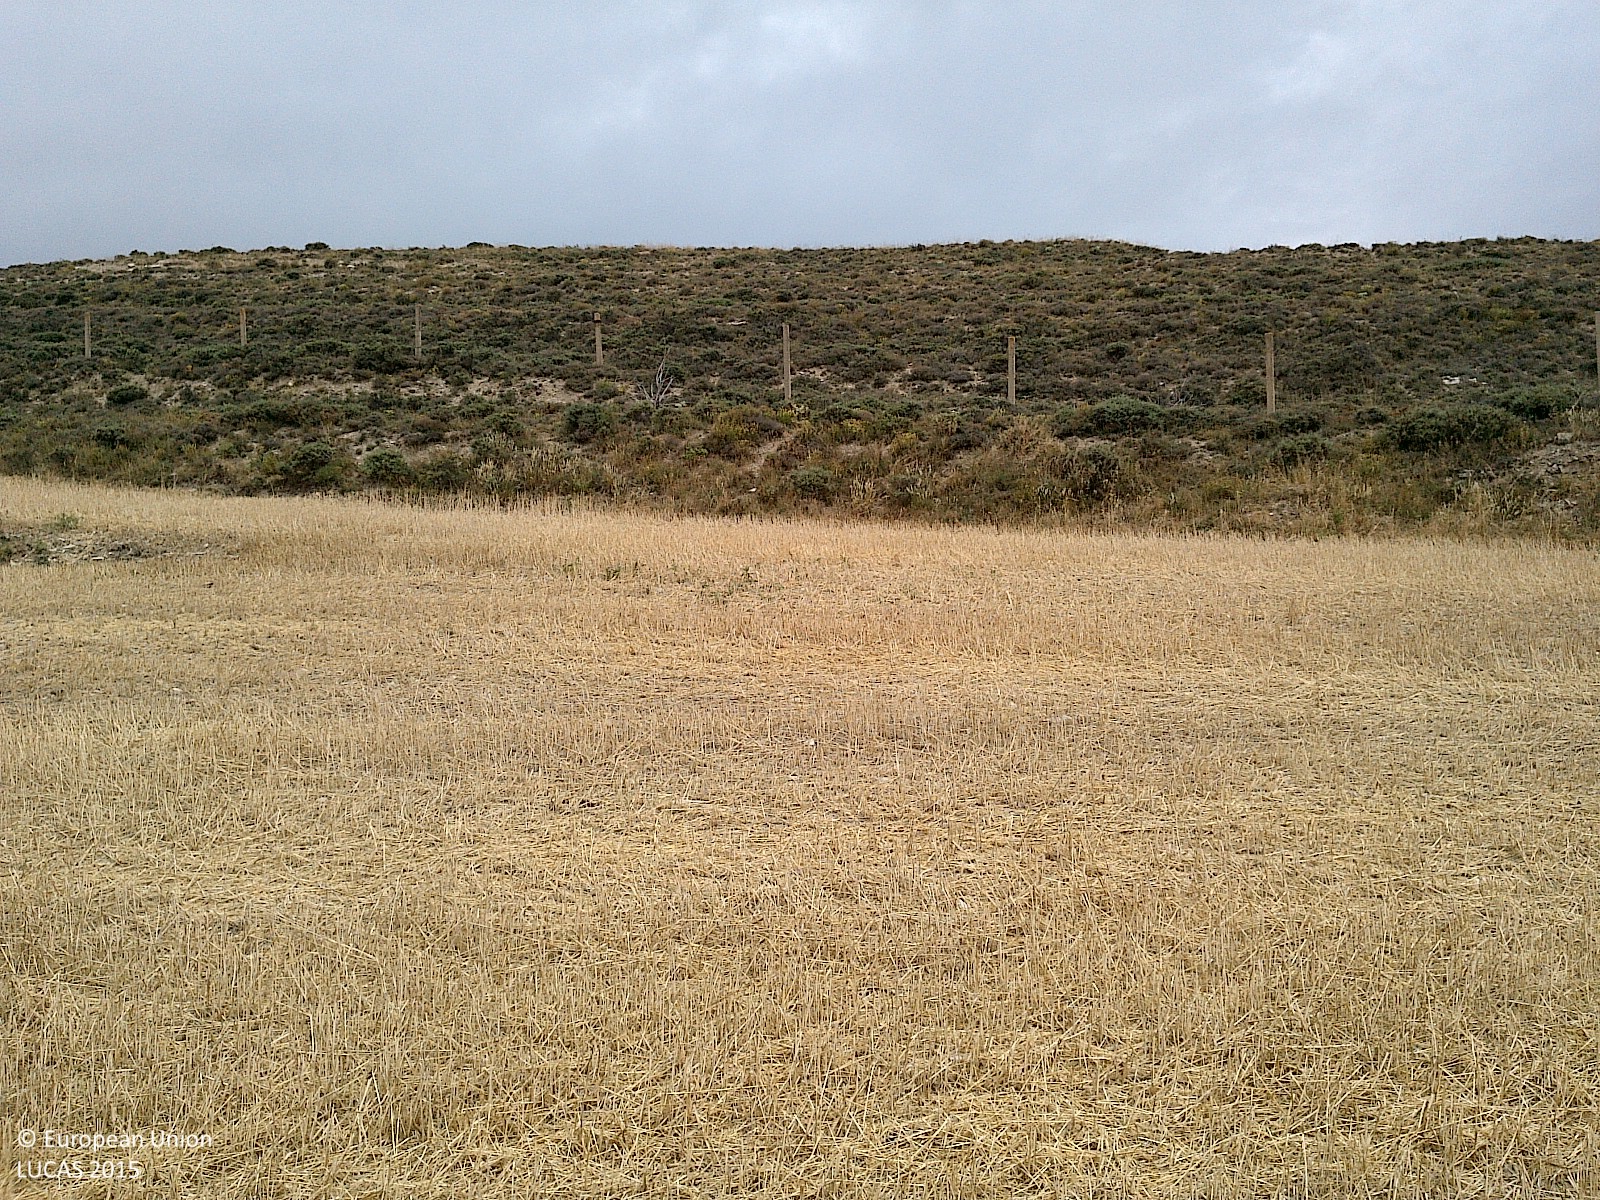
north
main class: Cropland
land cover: Durum wheat
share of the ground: < 10 %
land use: Agriculture (excluding fallow land and kitchen gardens)
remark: Harvested field
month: July
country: ES
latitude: 42.0053
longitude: -2.1957
